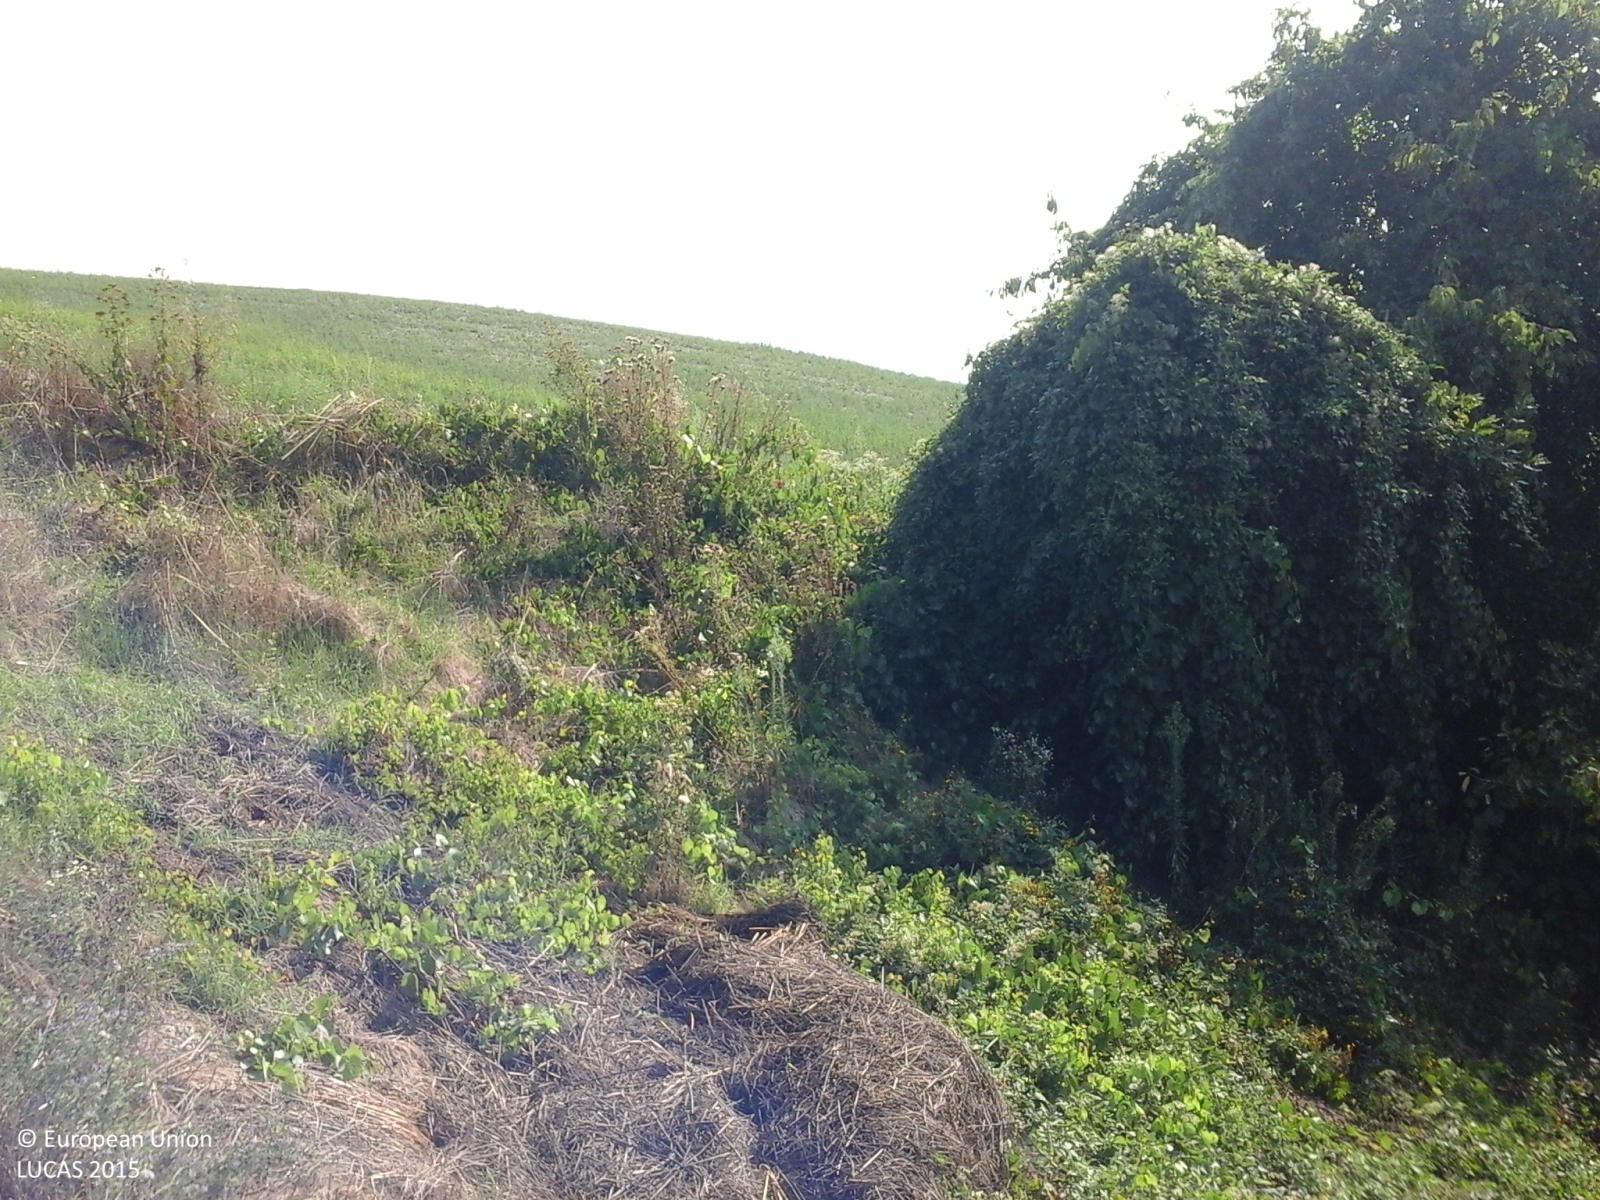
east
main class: Cropland
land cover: Lucerne
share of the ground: > 75 %
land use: Agriculture (excluding fallow land and kitchen gardens)
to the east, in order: Lucerne; Shrubland with sparse tree cover; Lucerne; Spontaneously vegetated surfaces; Paved roads, cycling and walking lanes; Electric lines; Grass margins
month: August
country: IT
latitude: 44.9063
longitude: 9.1784
